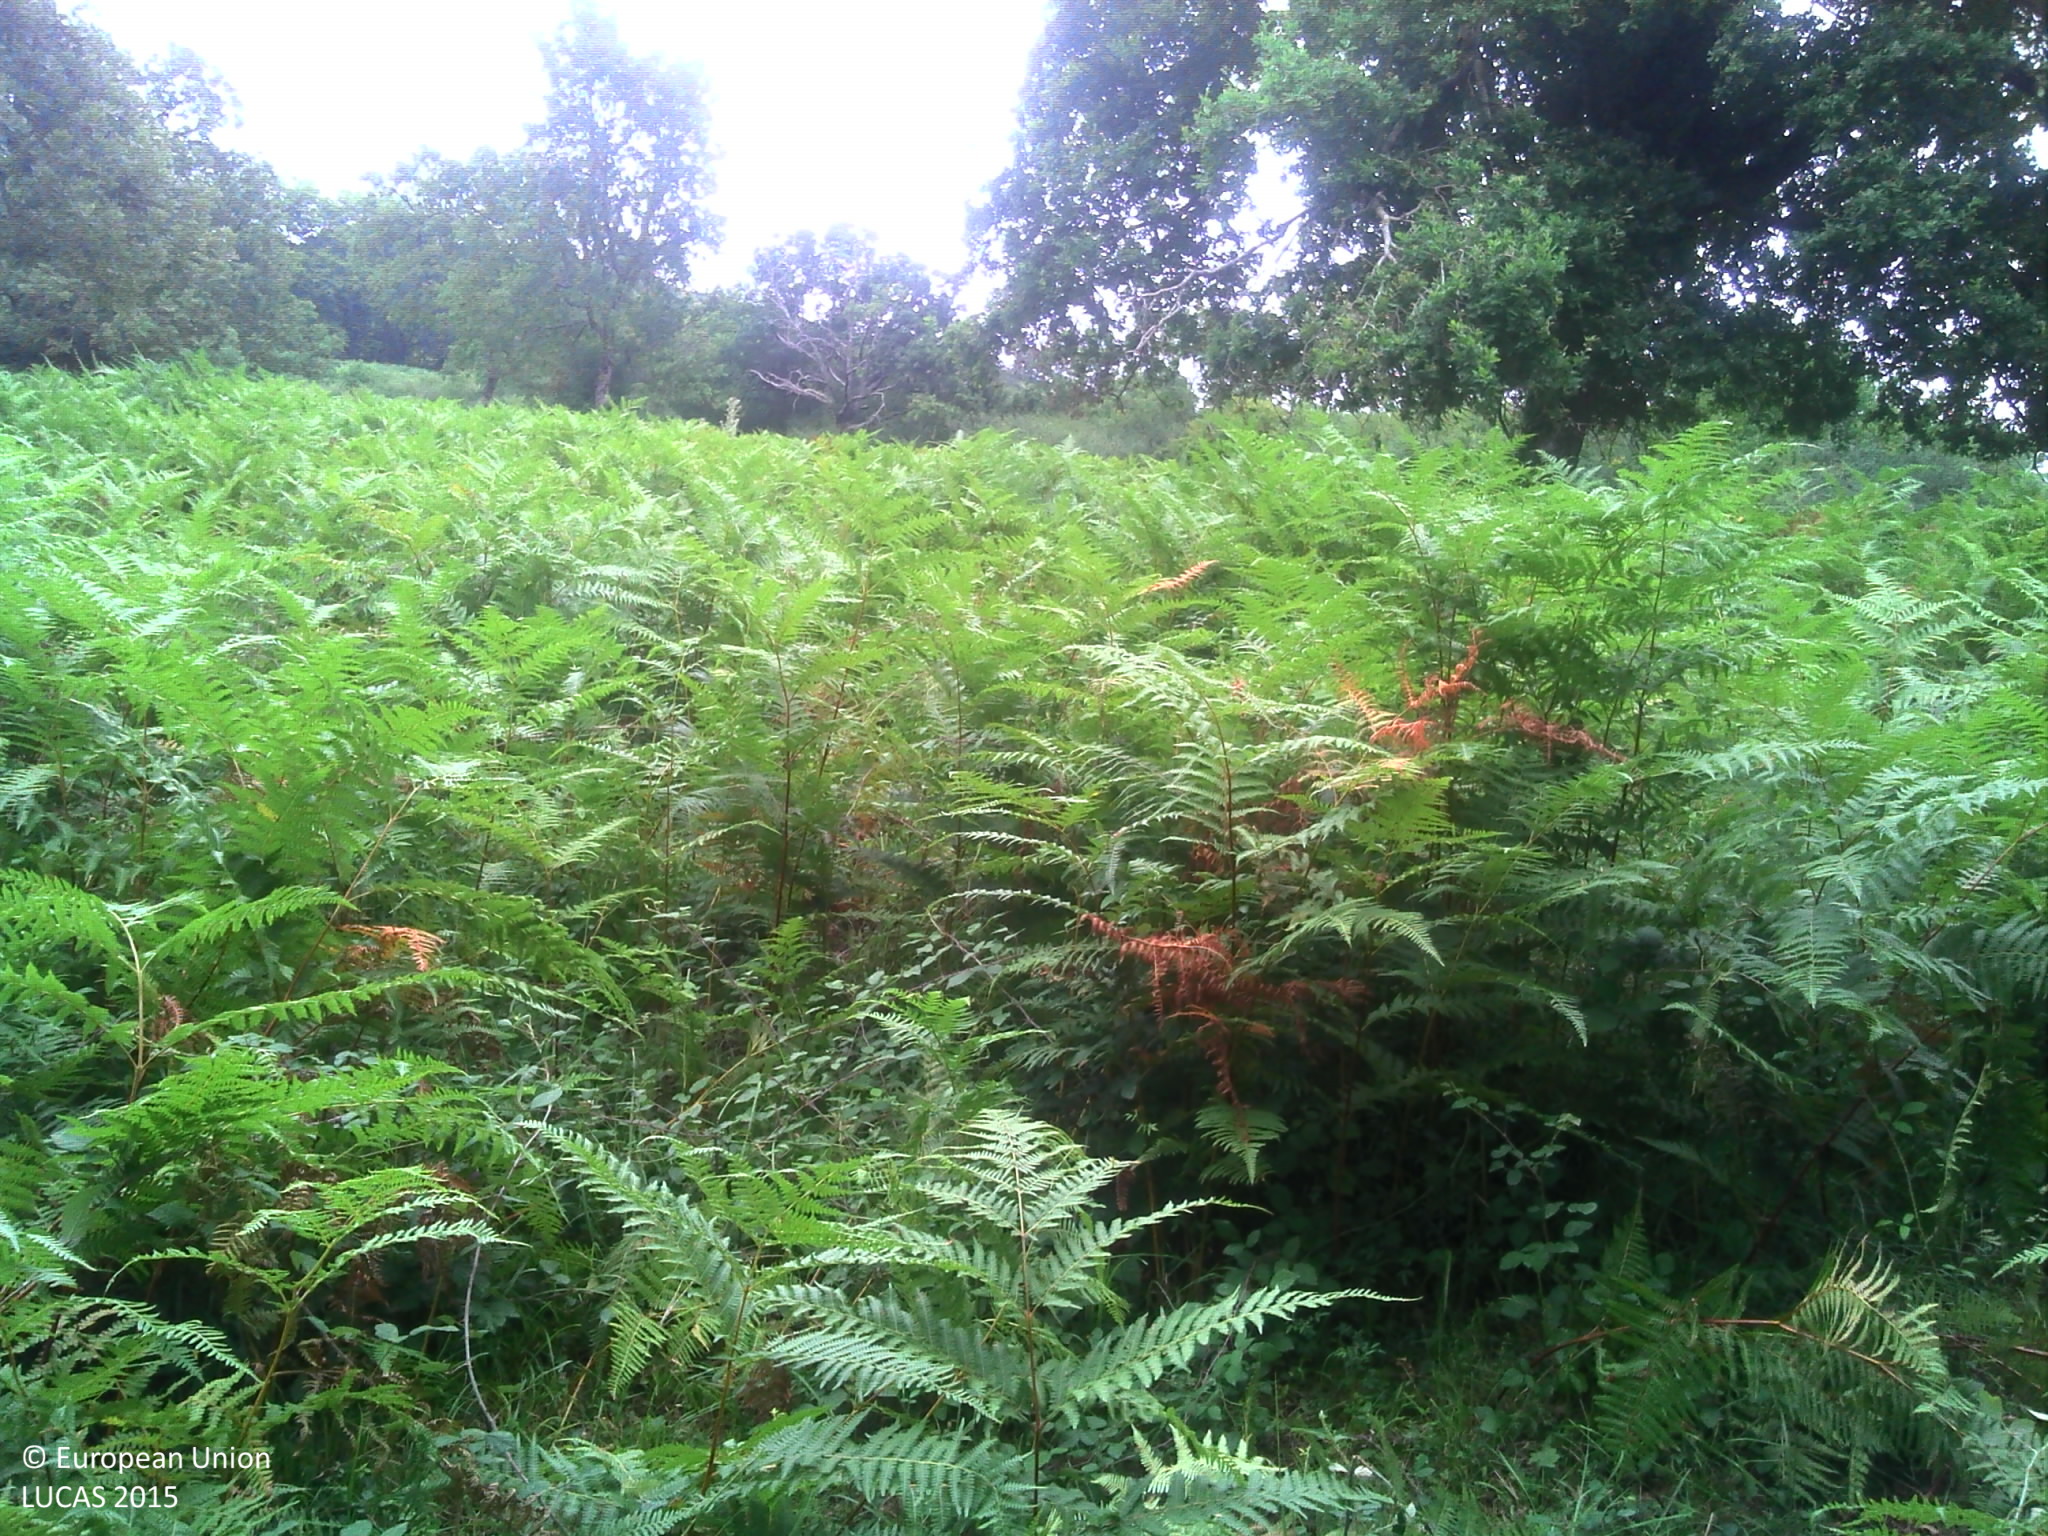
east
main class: Woodland
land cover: Broadleaved woodland
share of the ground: 10 - 25 %
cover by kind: broadleaved forest trees 100 %
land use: Forestry
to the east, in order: Broadleaved woodland; Shrubland with sparse tree cover; Shrubland without tree cover; Tracks; Broadleaved woodland; Shrubland without tree cover; Tracks; Shrubland without tree cover; Broadleaved woodland
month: August
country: FR
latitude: 43.2498
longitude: -1.2097
